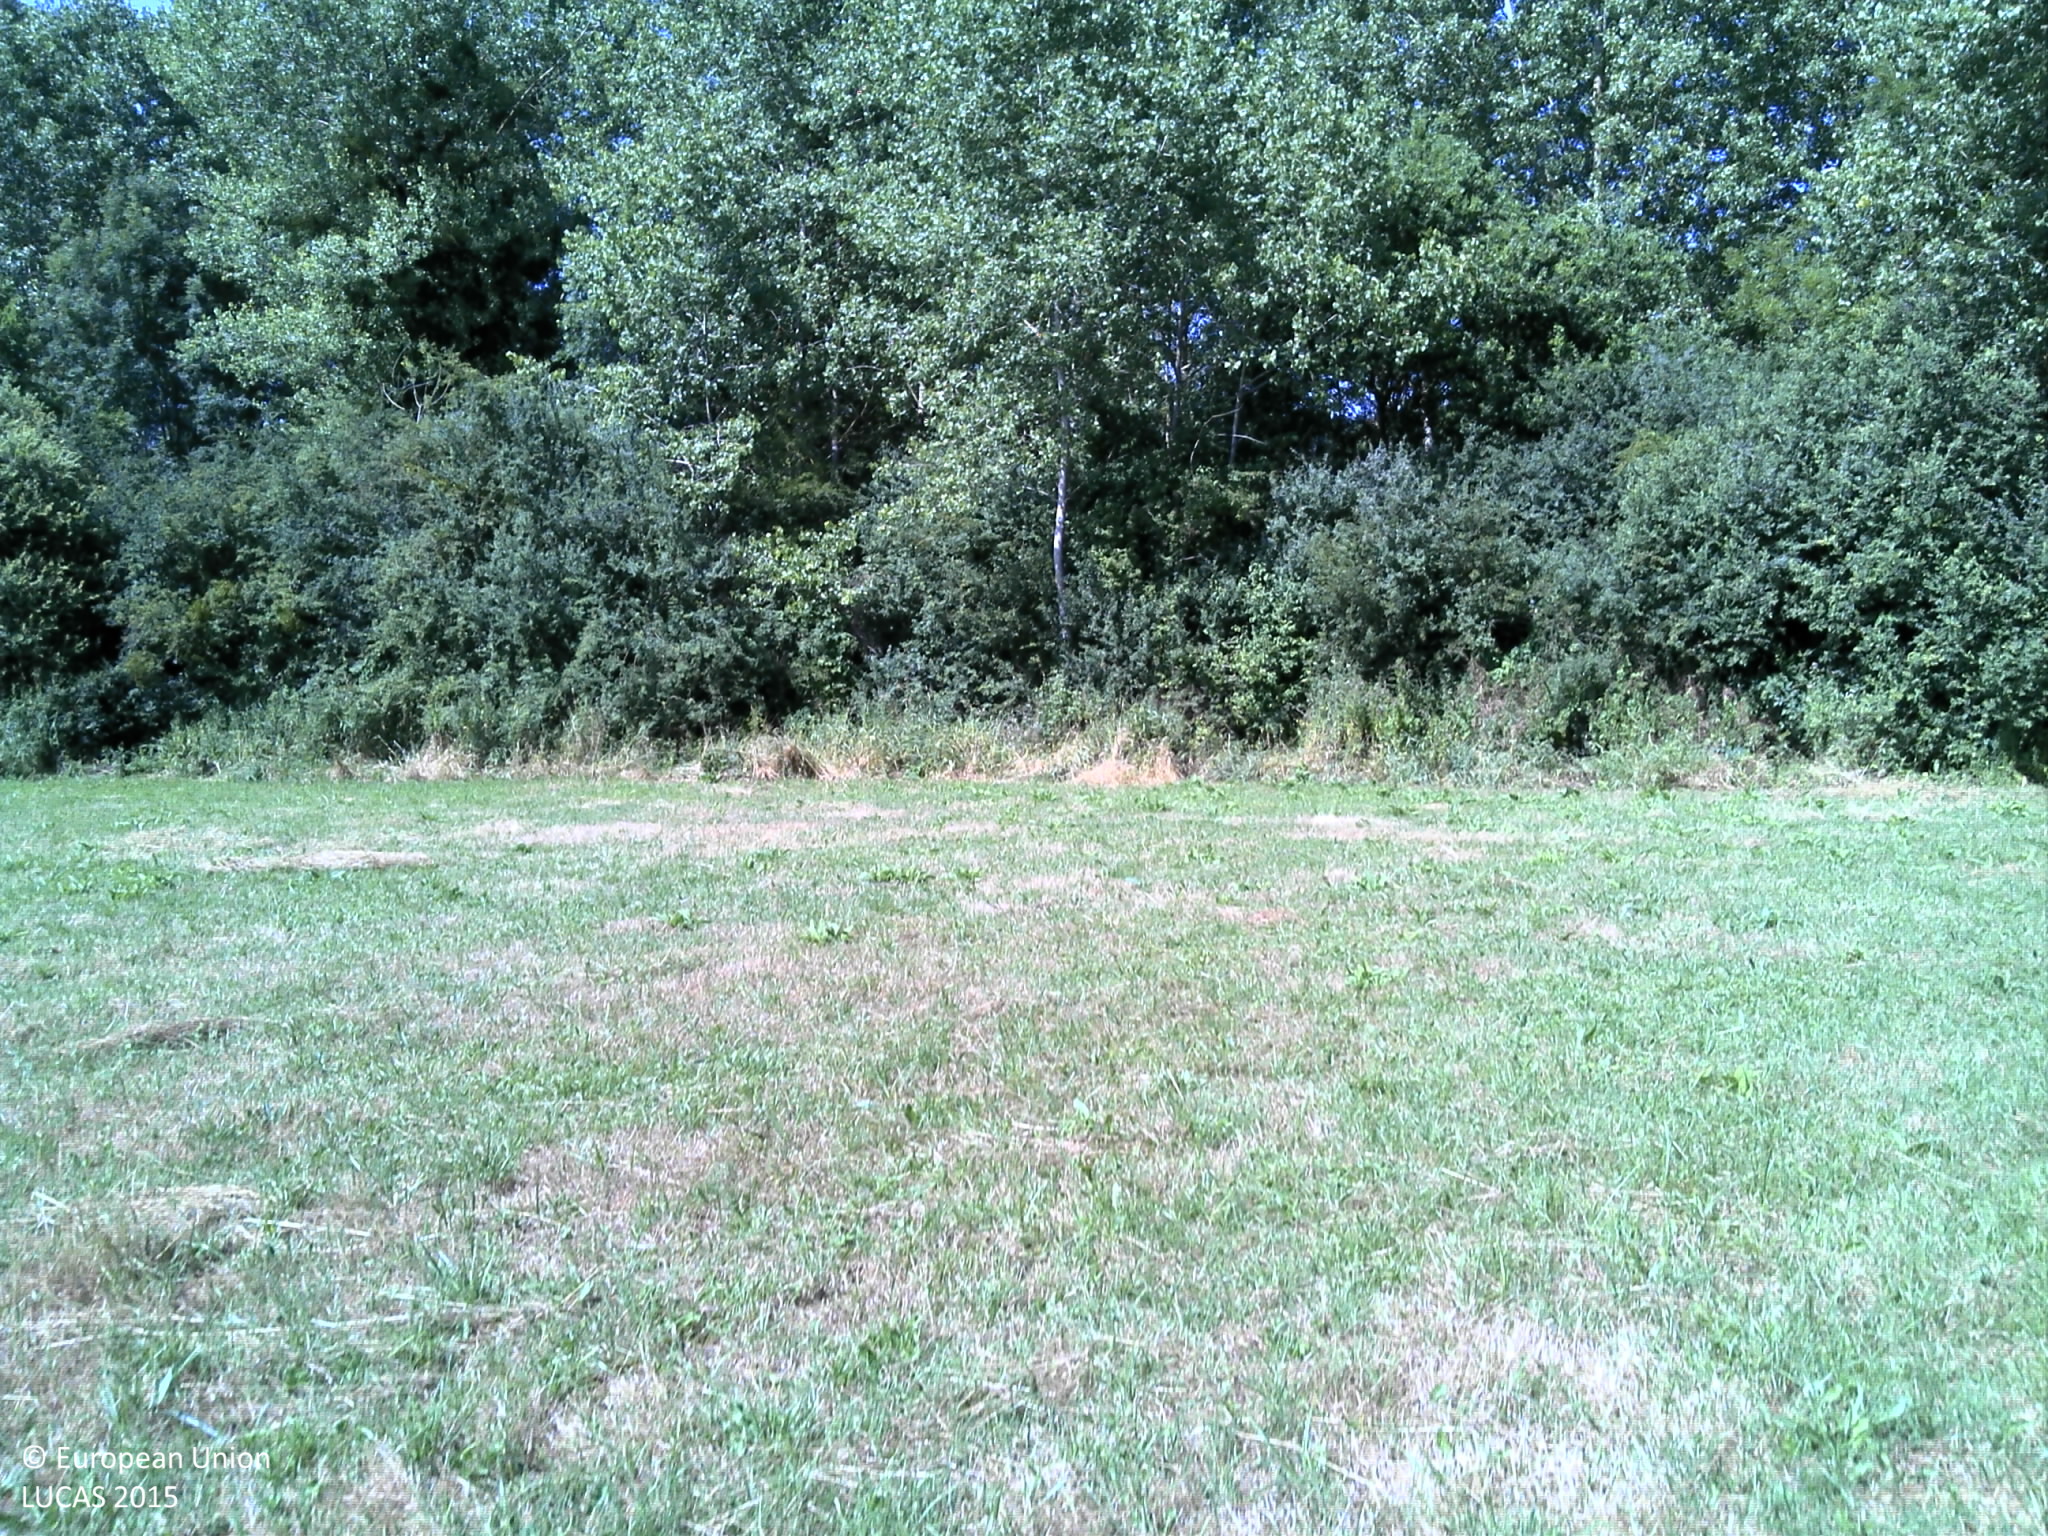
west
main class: Grassland
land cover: Grassland without tree/shrub cover
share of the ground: > 75 %
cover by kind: herbaceous plants 100 %
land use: Agriculture (excluding fallow land and kitchen gardens)
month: July
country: FR
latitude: 48.6738
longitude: 4.7148
